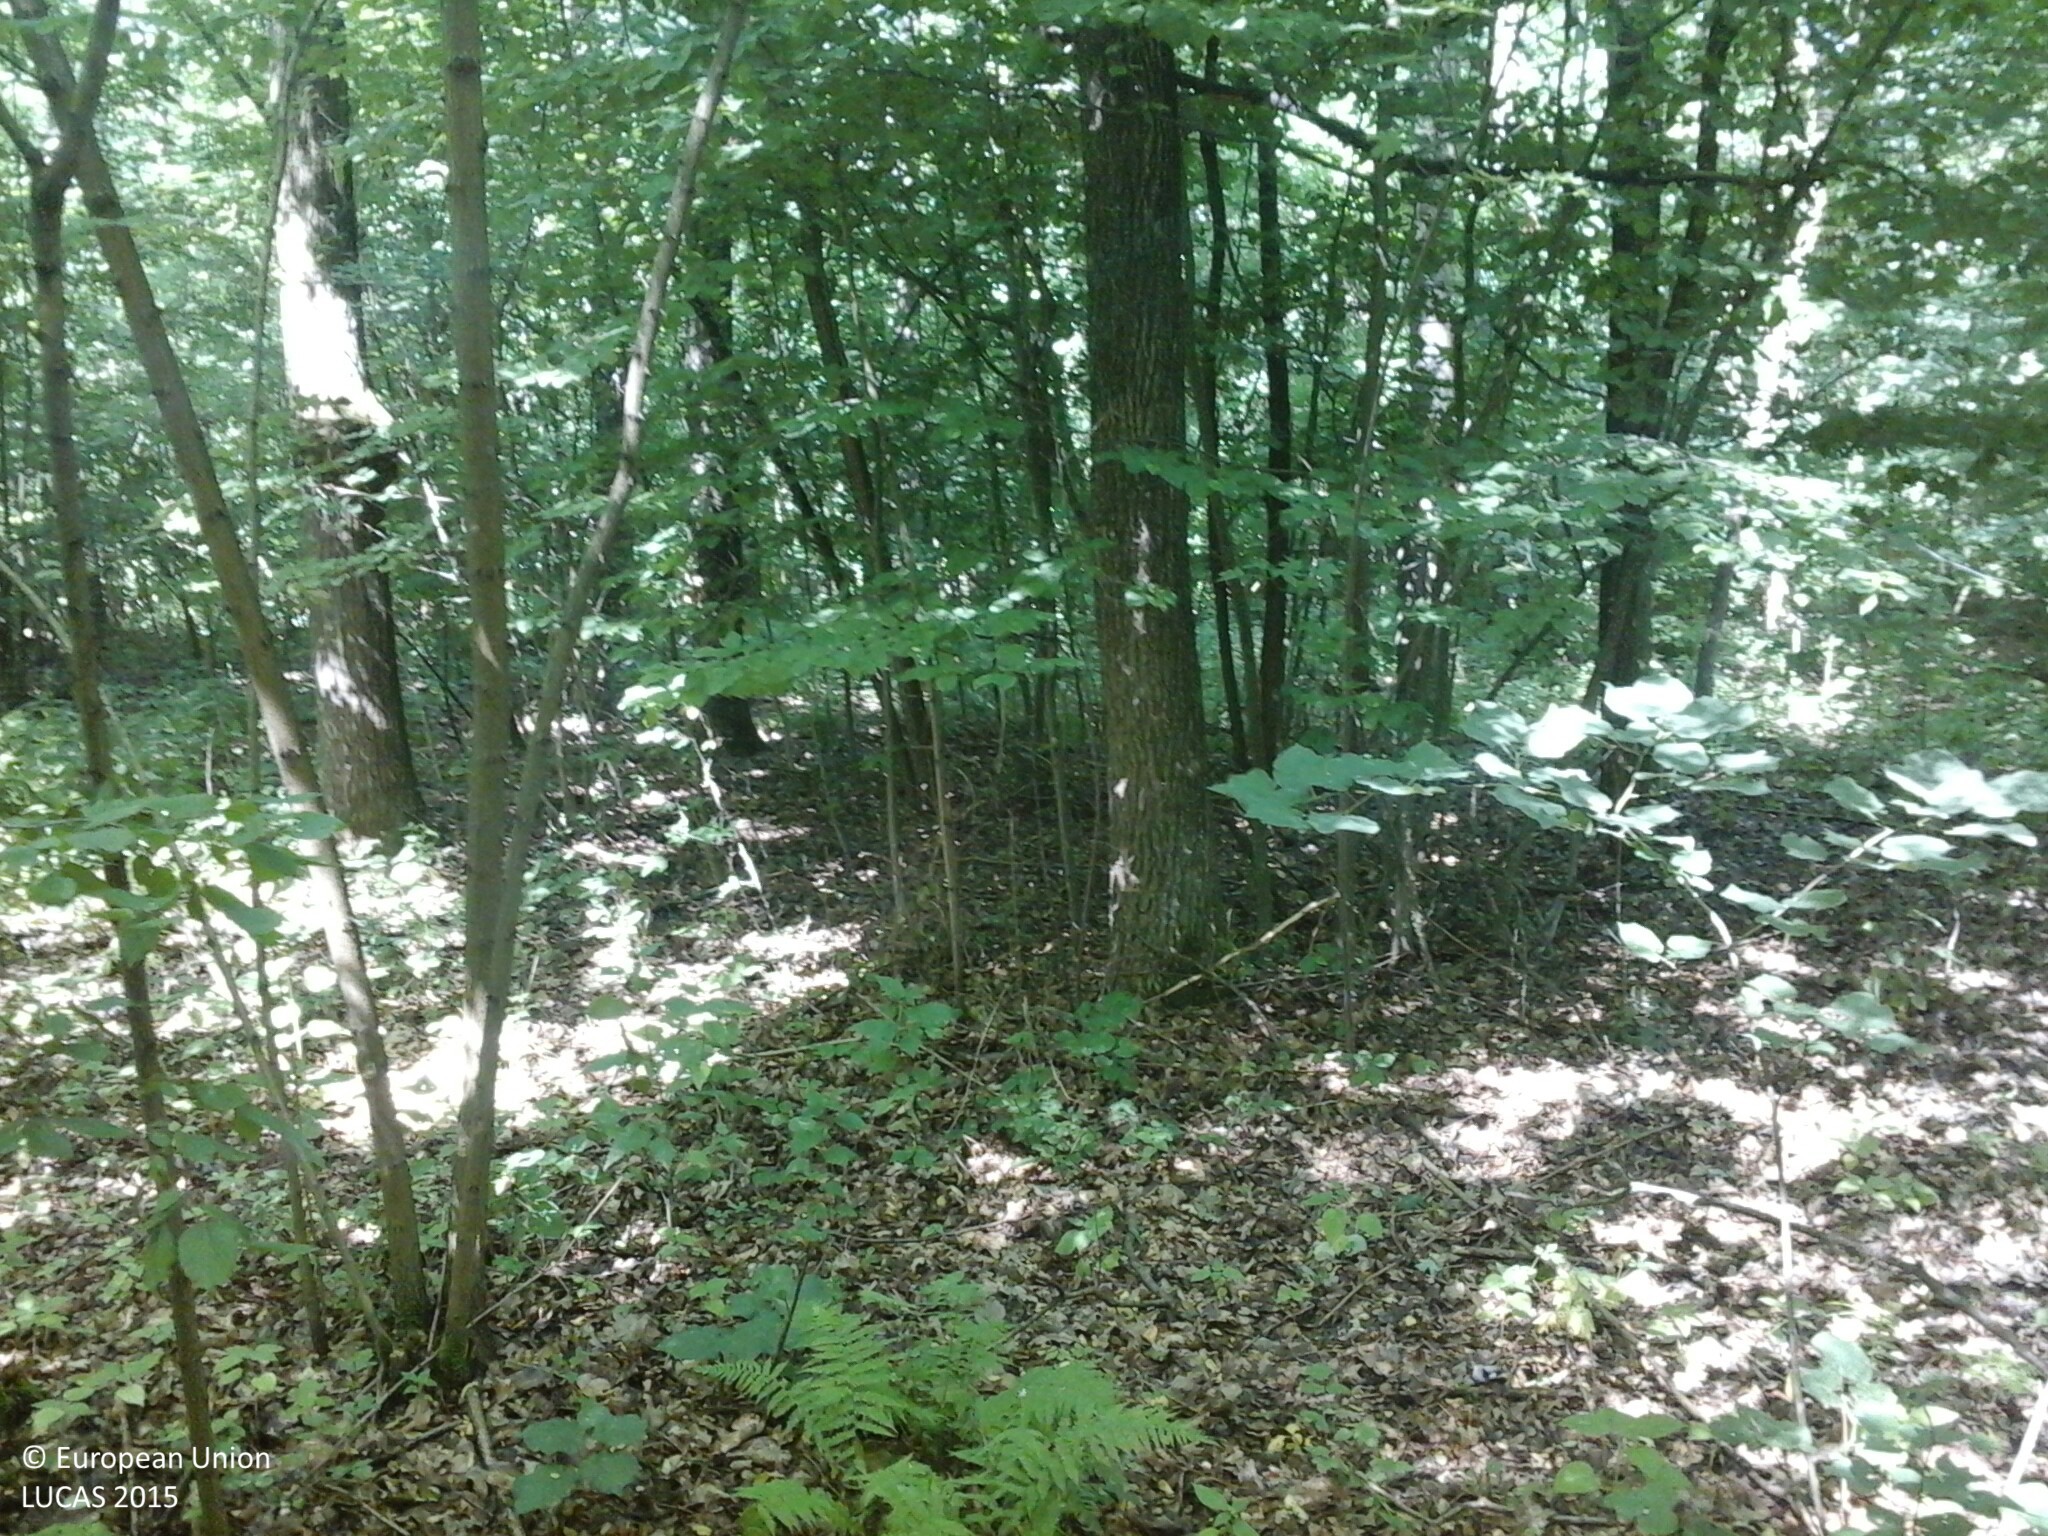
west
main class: Woodland
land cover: Broadleaved woodland
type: mesophytic deciduous forest
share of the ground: > 75 %
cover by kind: broadleaved forest trees 90 %, herbaceous plants 10 %
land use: Forestry
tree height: > 5 m
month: July
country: HU
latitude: 48.0616
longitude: 22.2808
